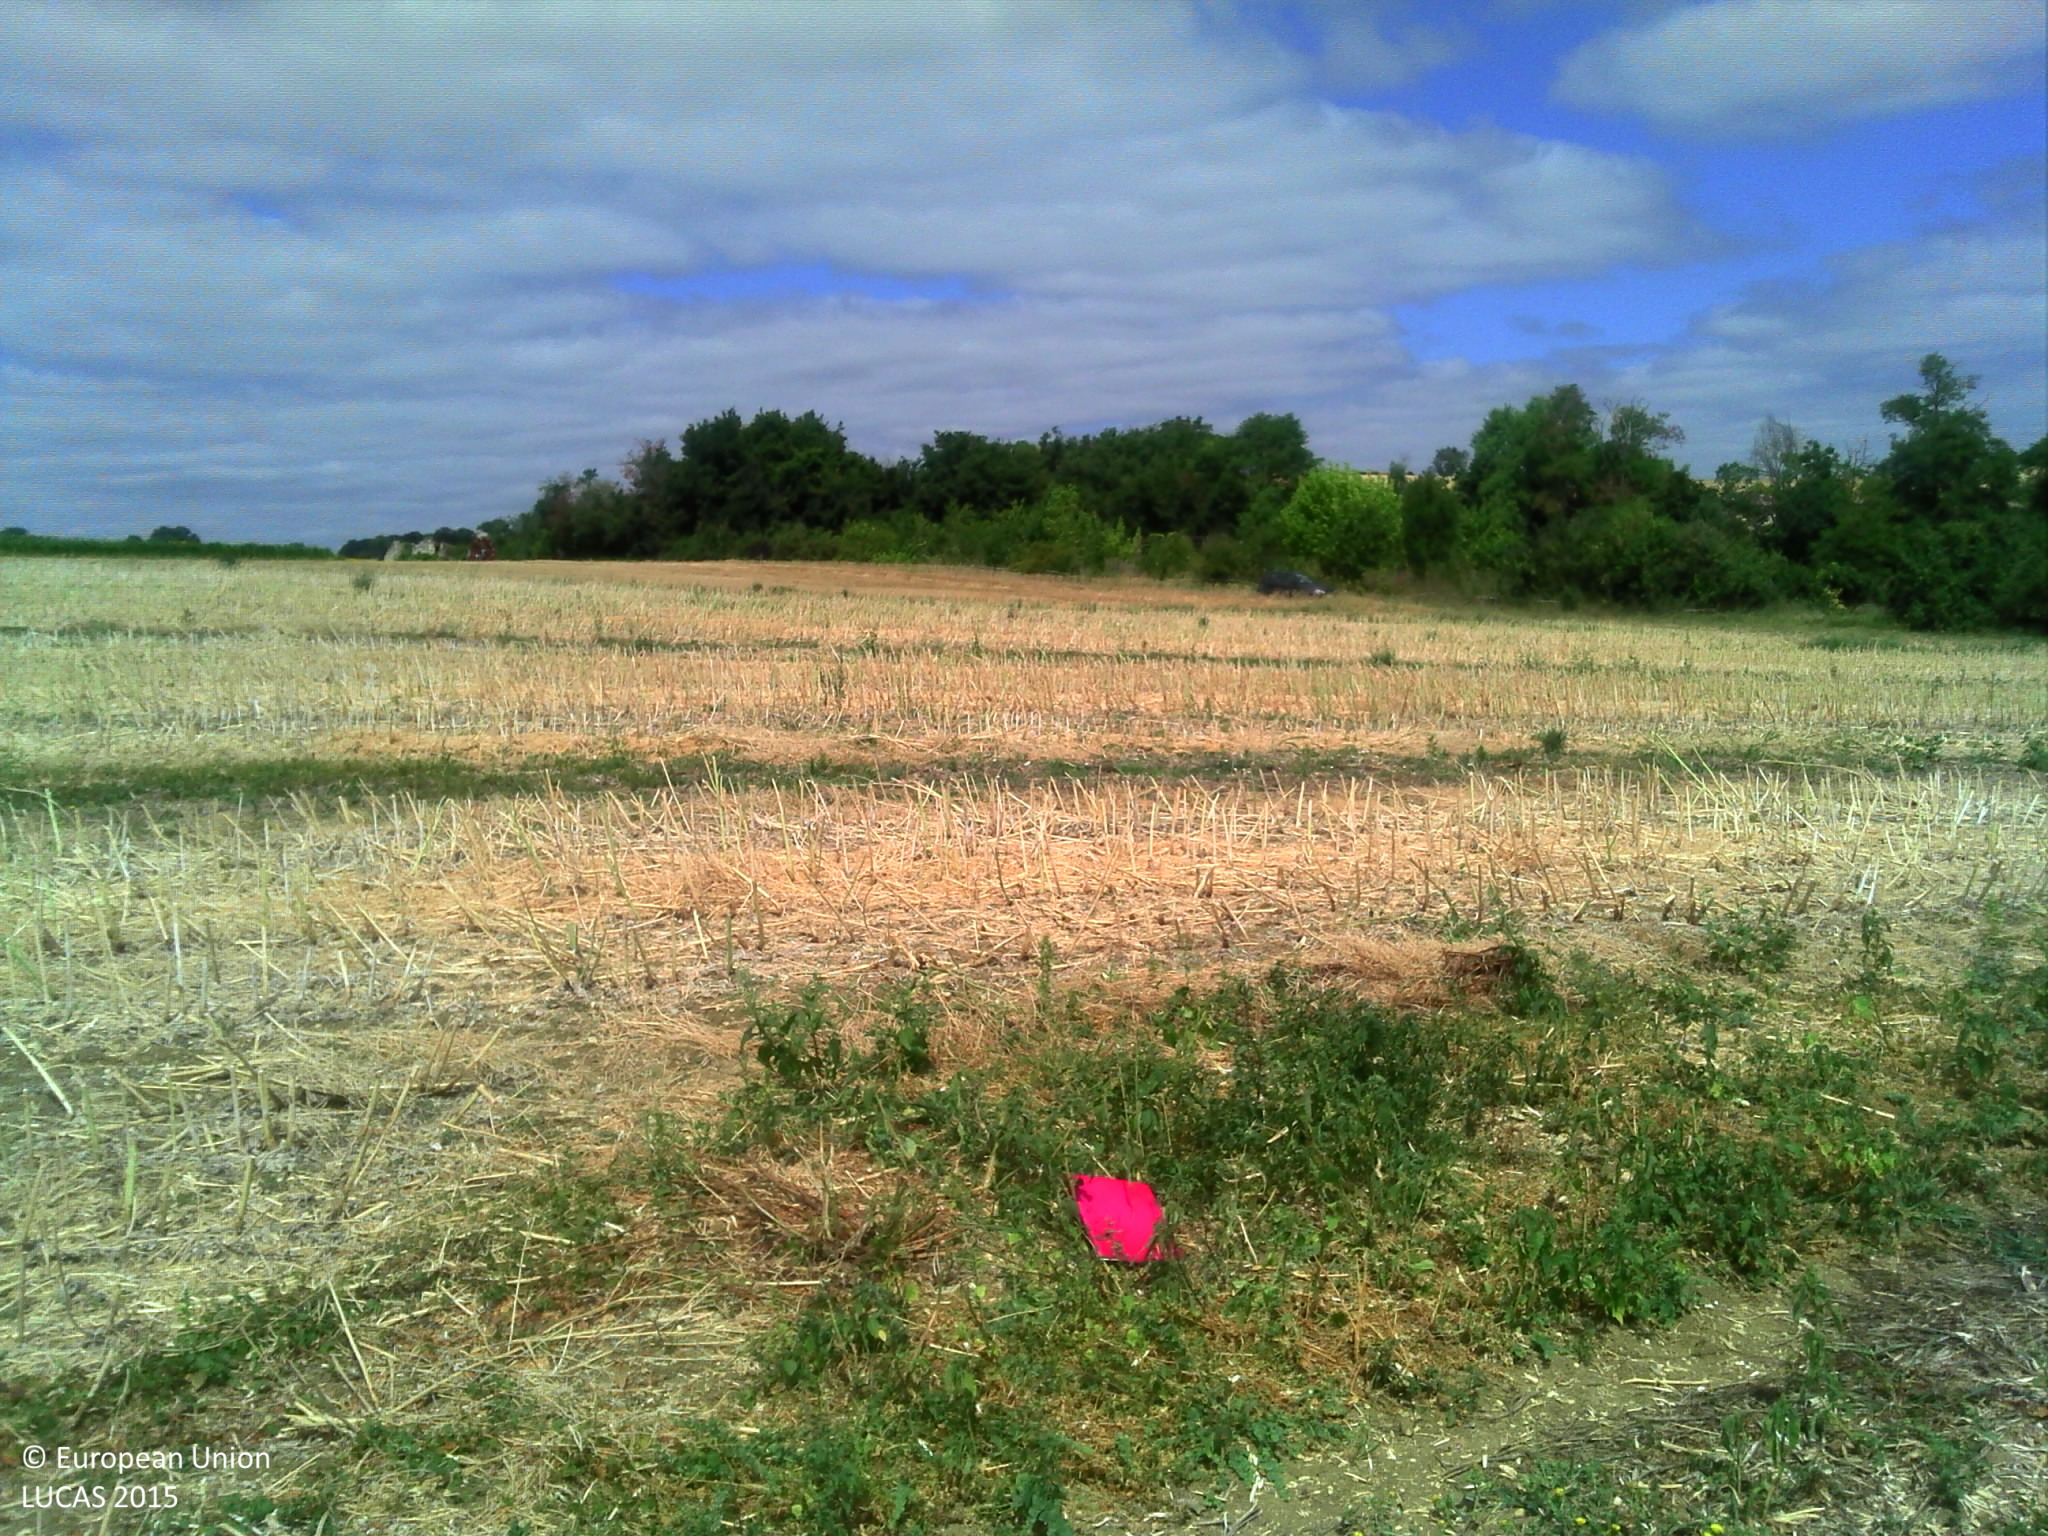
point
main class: Cropland
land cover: Rape and turnip rape
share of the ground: > 75 %
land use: Agriculture (excluding fallow land and kitchen gardens)
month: July
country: FR
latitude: 43.9157
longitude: 0.7192
